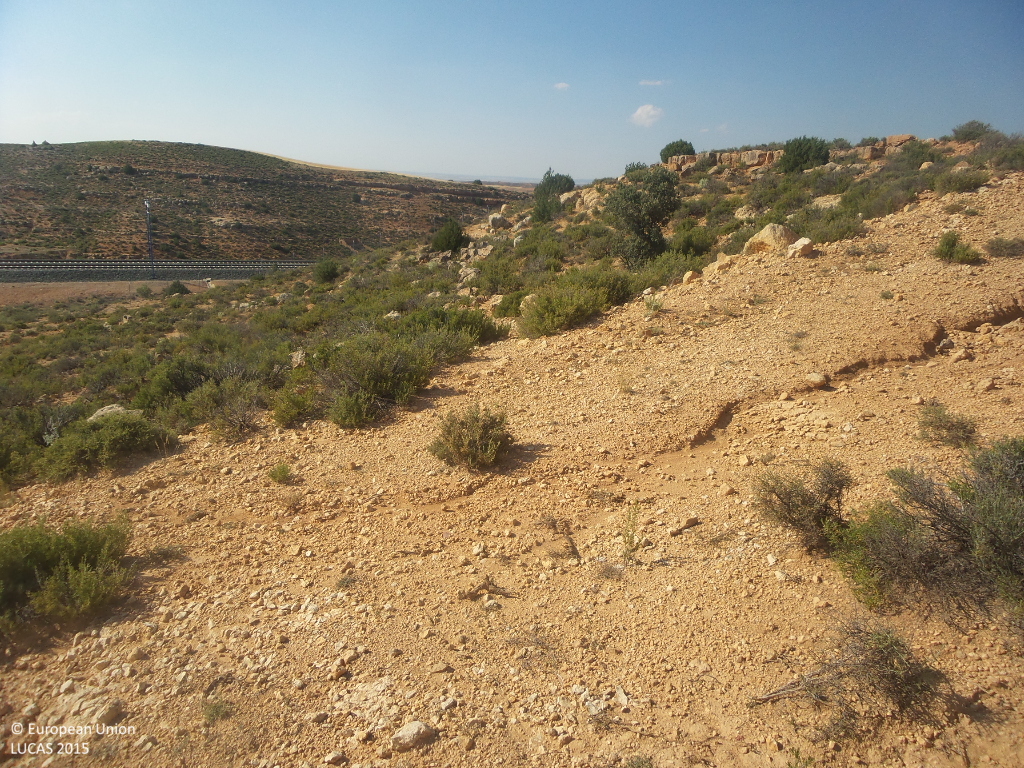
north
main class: Shrubland
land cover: Shrubland without tree cover
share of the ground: 25 - 50 %
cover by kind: unconsolidated bare surface 70 %, shrubs 30 %
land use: Semi-natural and natural areas not in use
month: July
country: ES
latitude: 41.2099
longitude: -2.1338
